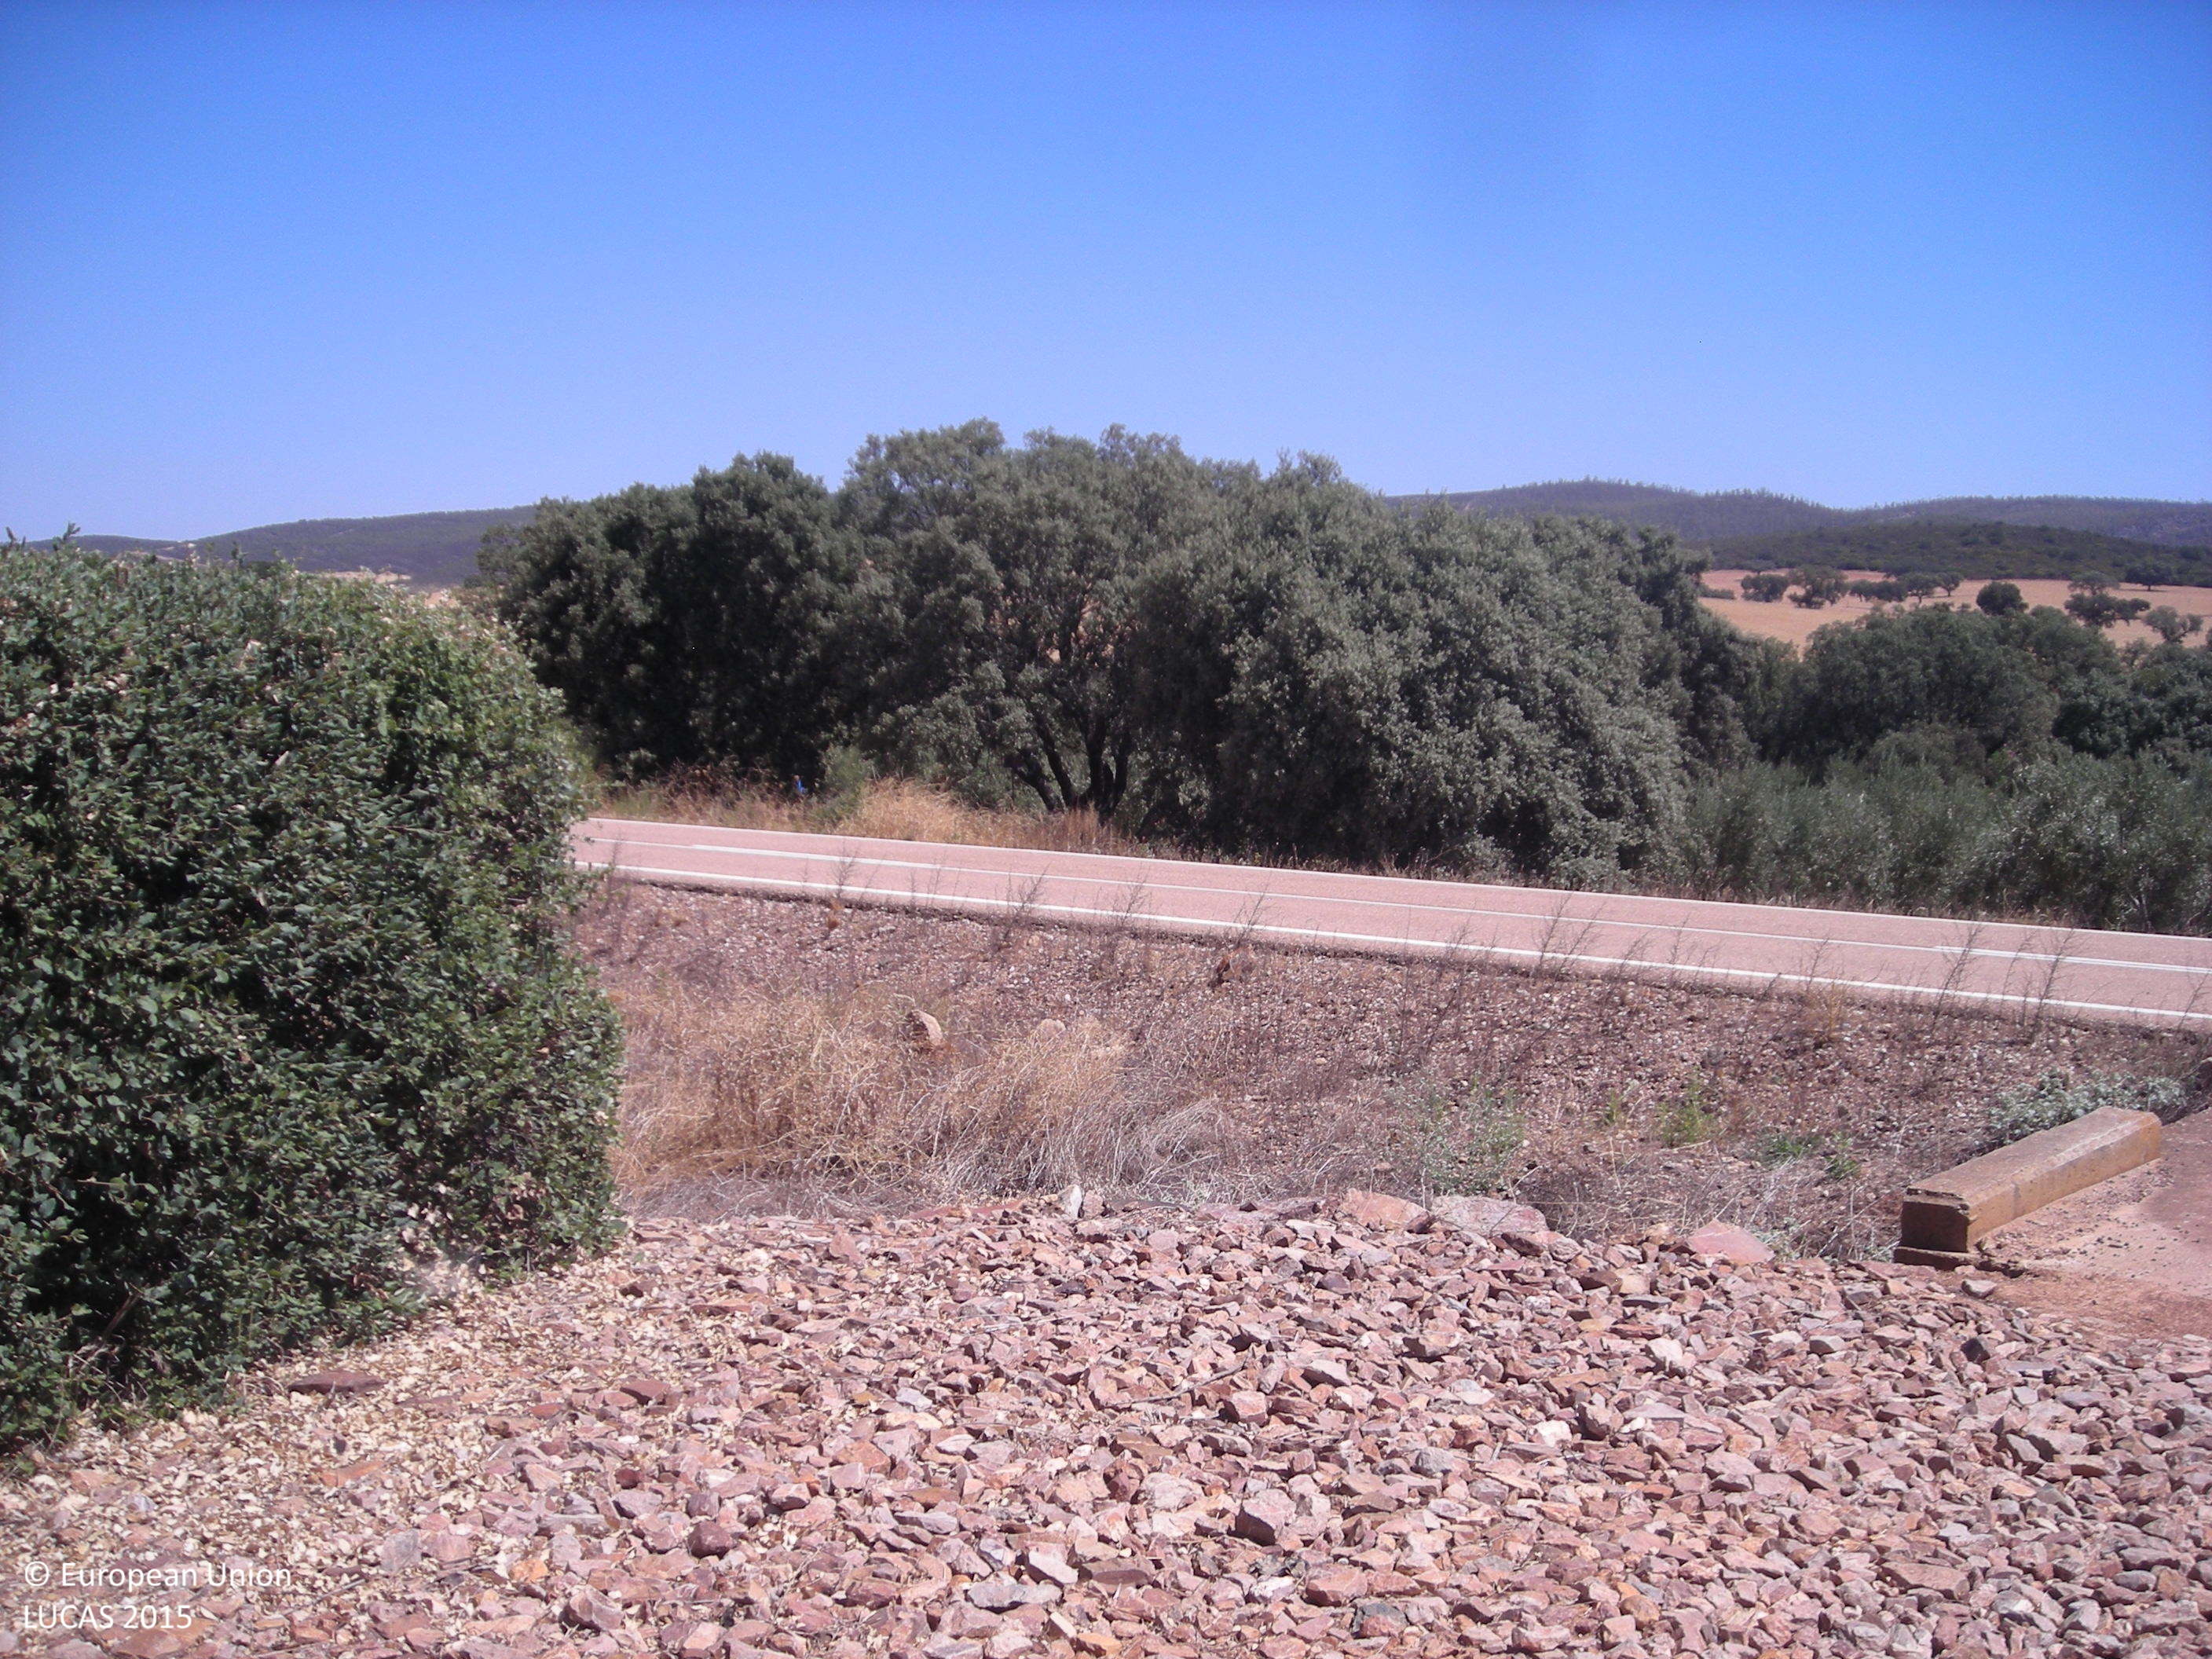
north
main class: Woodland
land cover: Broadleaved woodland
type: broadleaved evergreen forest
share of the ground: 25 - 50 %
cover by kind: broadleaved forest trees 40 %, shrubs 30 %, herbaceous plants 30 %
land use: Forestry
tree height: > 5 m
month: July
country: ES
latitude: 38.7638
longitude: -5.8704
